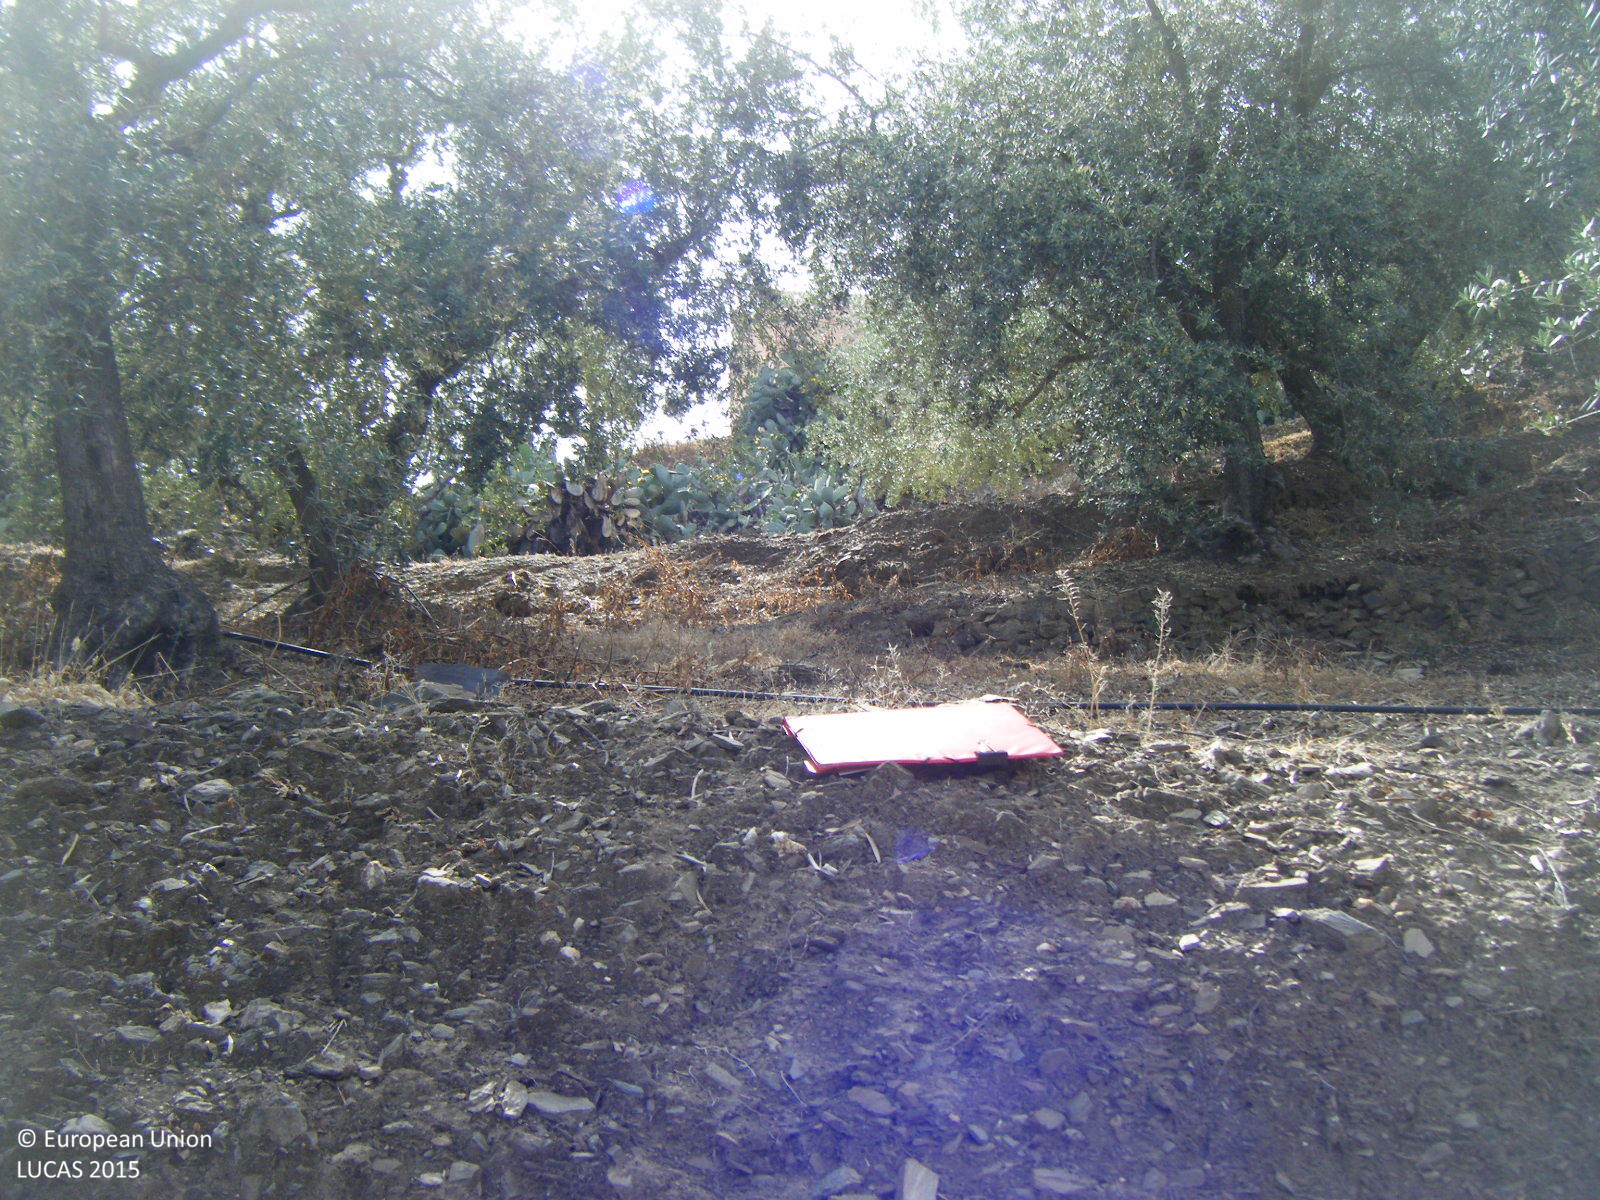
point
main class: Cropland
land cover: Olive groves
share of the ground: 25 - 50 %
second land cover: Other bare soil
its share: > 75 %
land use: Agriculture (excluding fallow land and kitchen gardens)
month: May
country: ES
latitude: 36.8150
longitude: -4.0108
